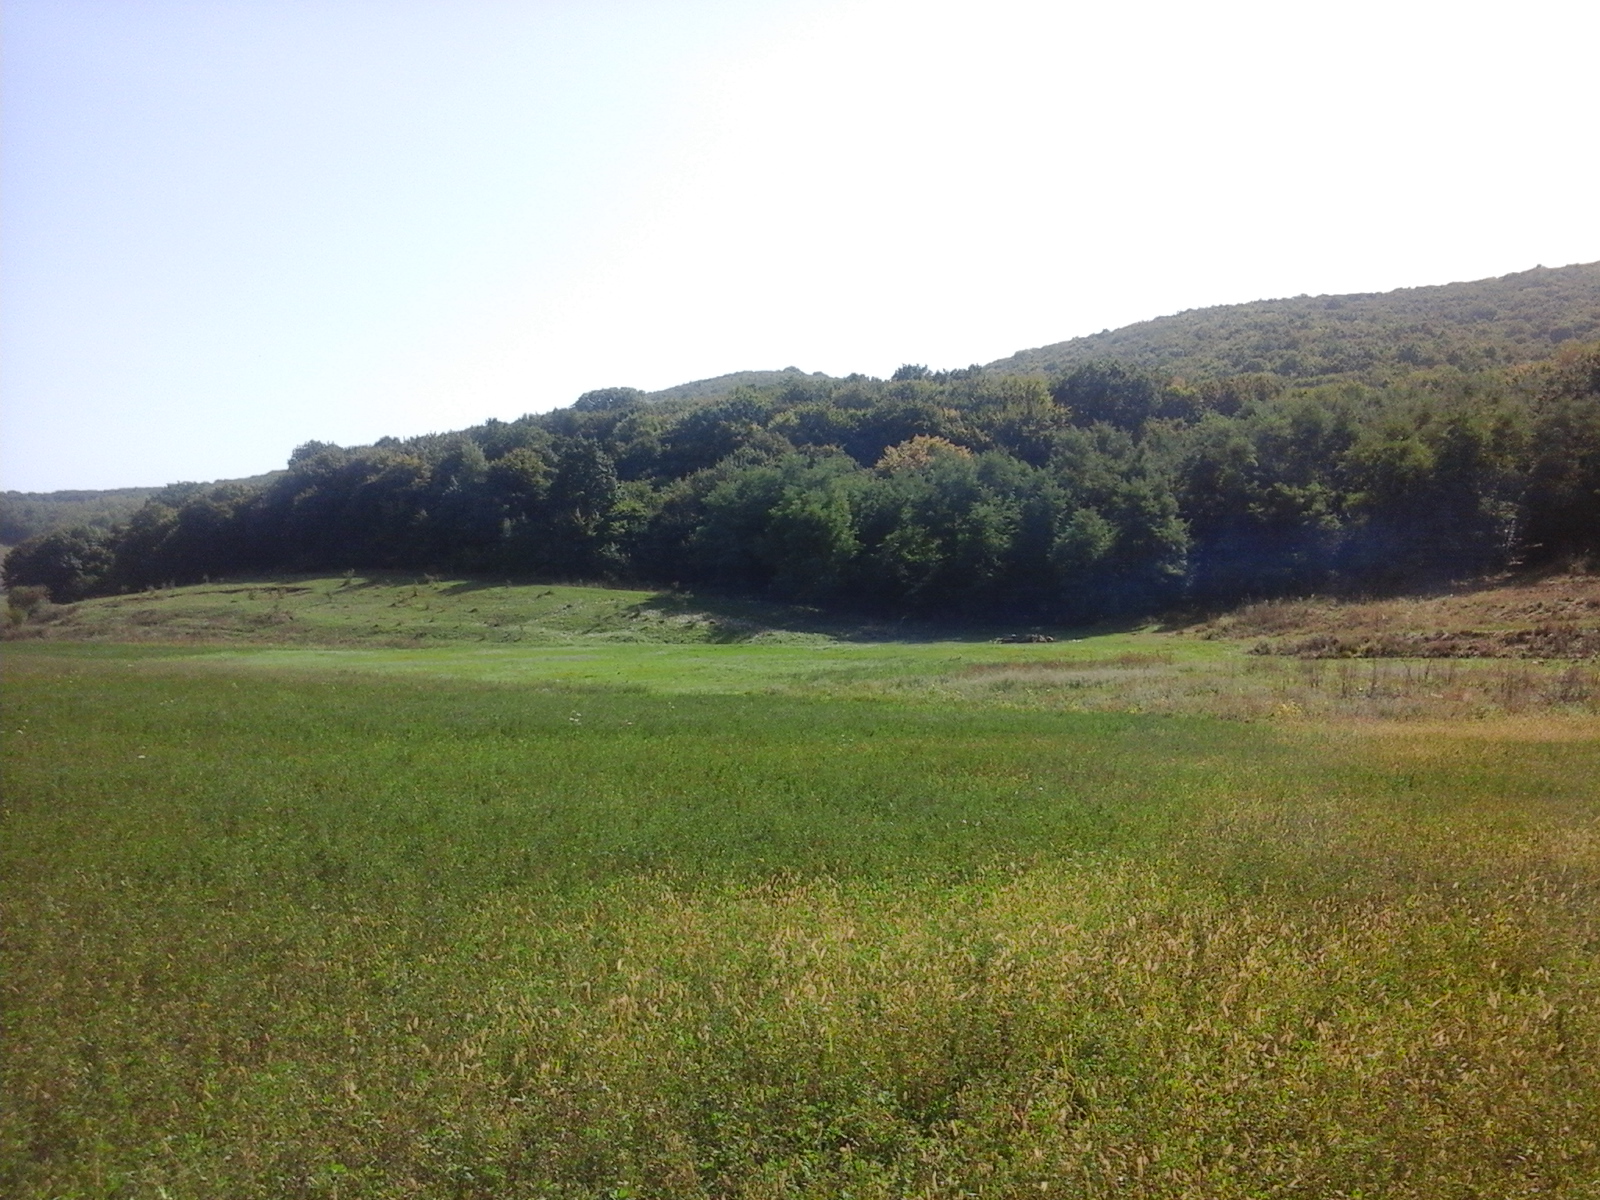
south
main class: Cropland
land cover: Maize
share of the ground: > 75 %
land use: Agriculture (excluding fallow land and kitchen gardens)
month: September
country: RO
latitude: 46.8641
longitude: 23.8904
